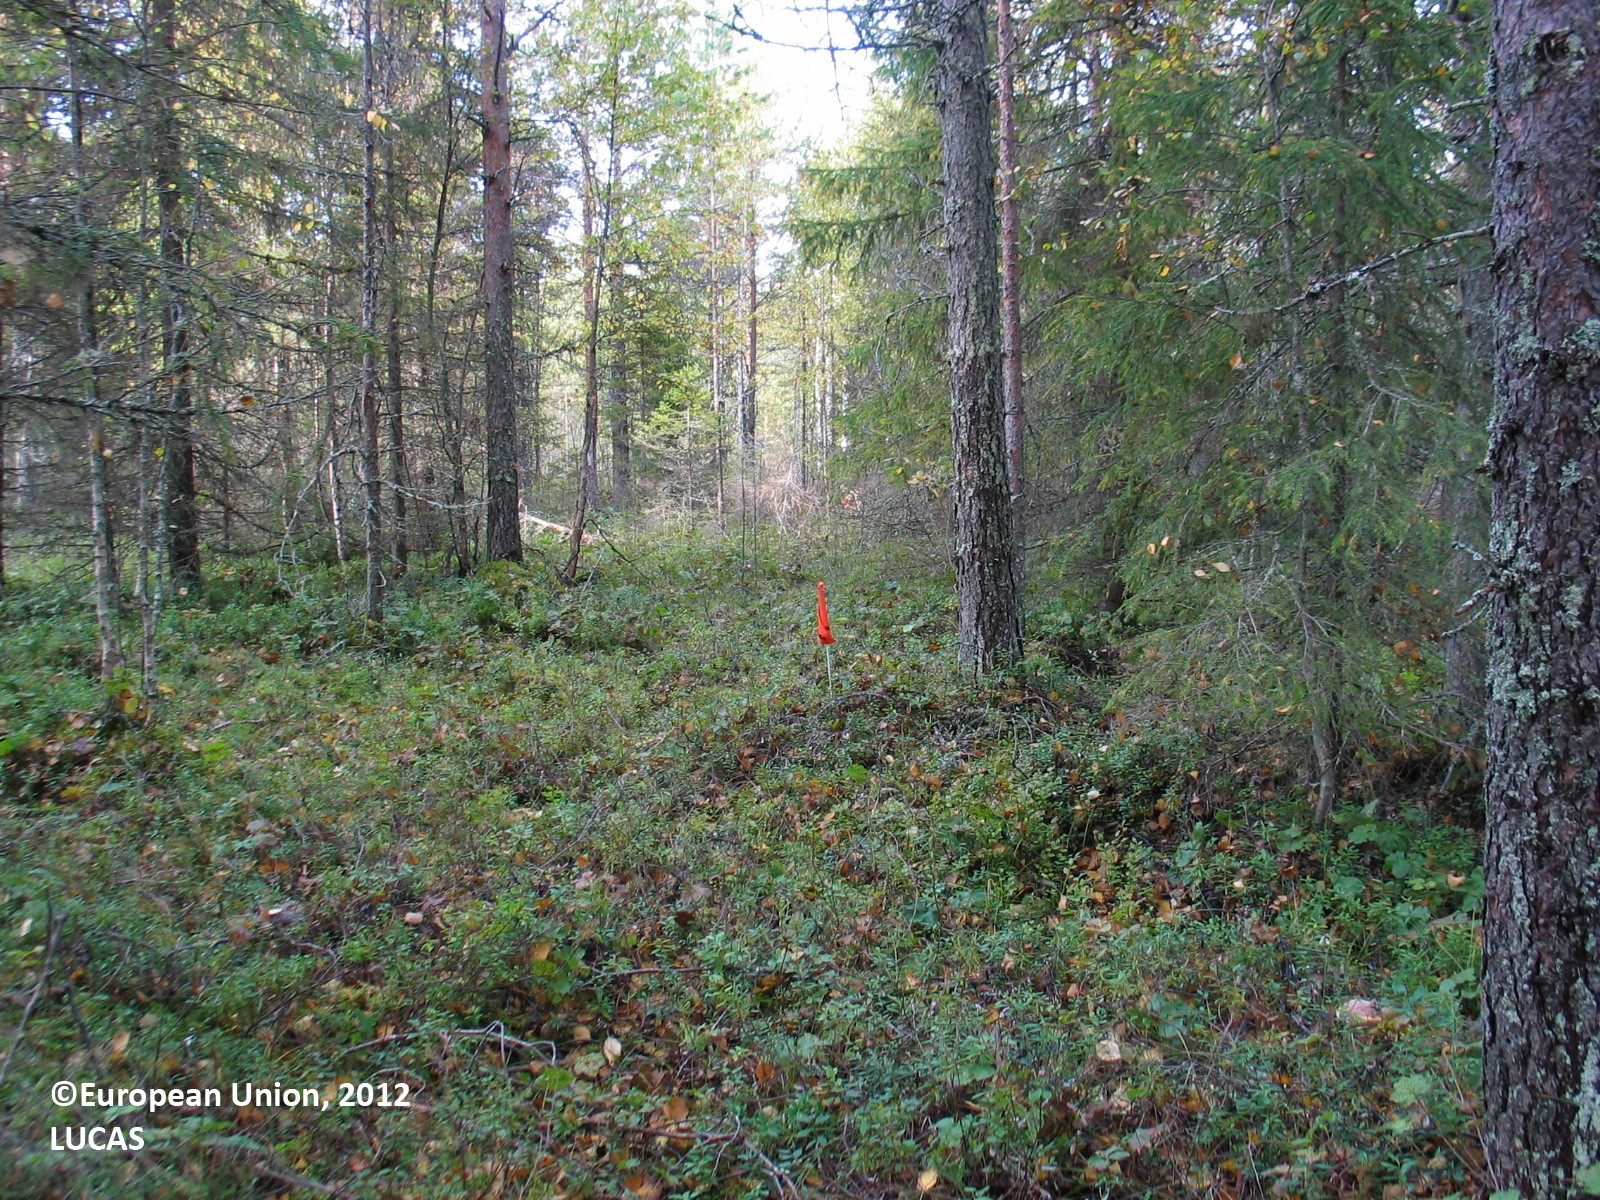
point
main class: Woodland
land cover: Other mixed woodland
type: mire and swamp forests
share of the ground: 25 - 50 %
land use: Forestry
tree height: > 5 m
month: September
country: FI
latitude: 65.6156
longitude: 25.8209
